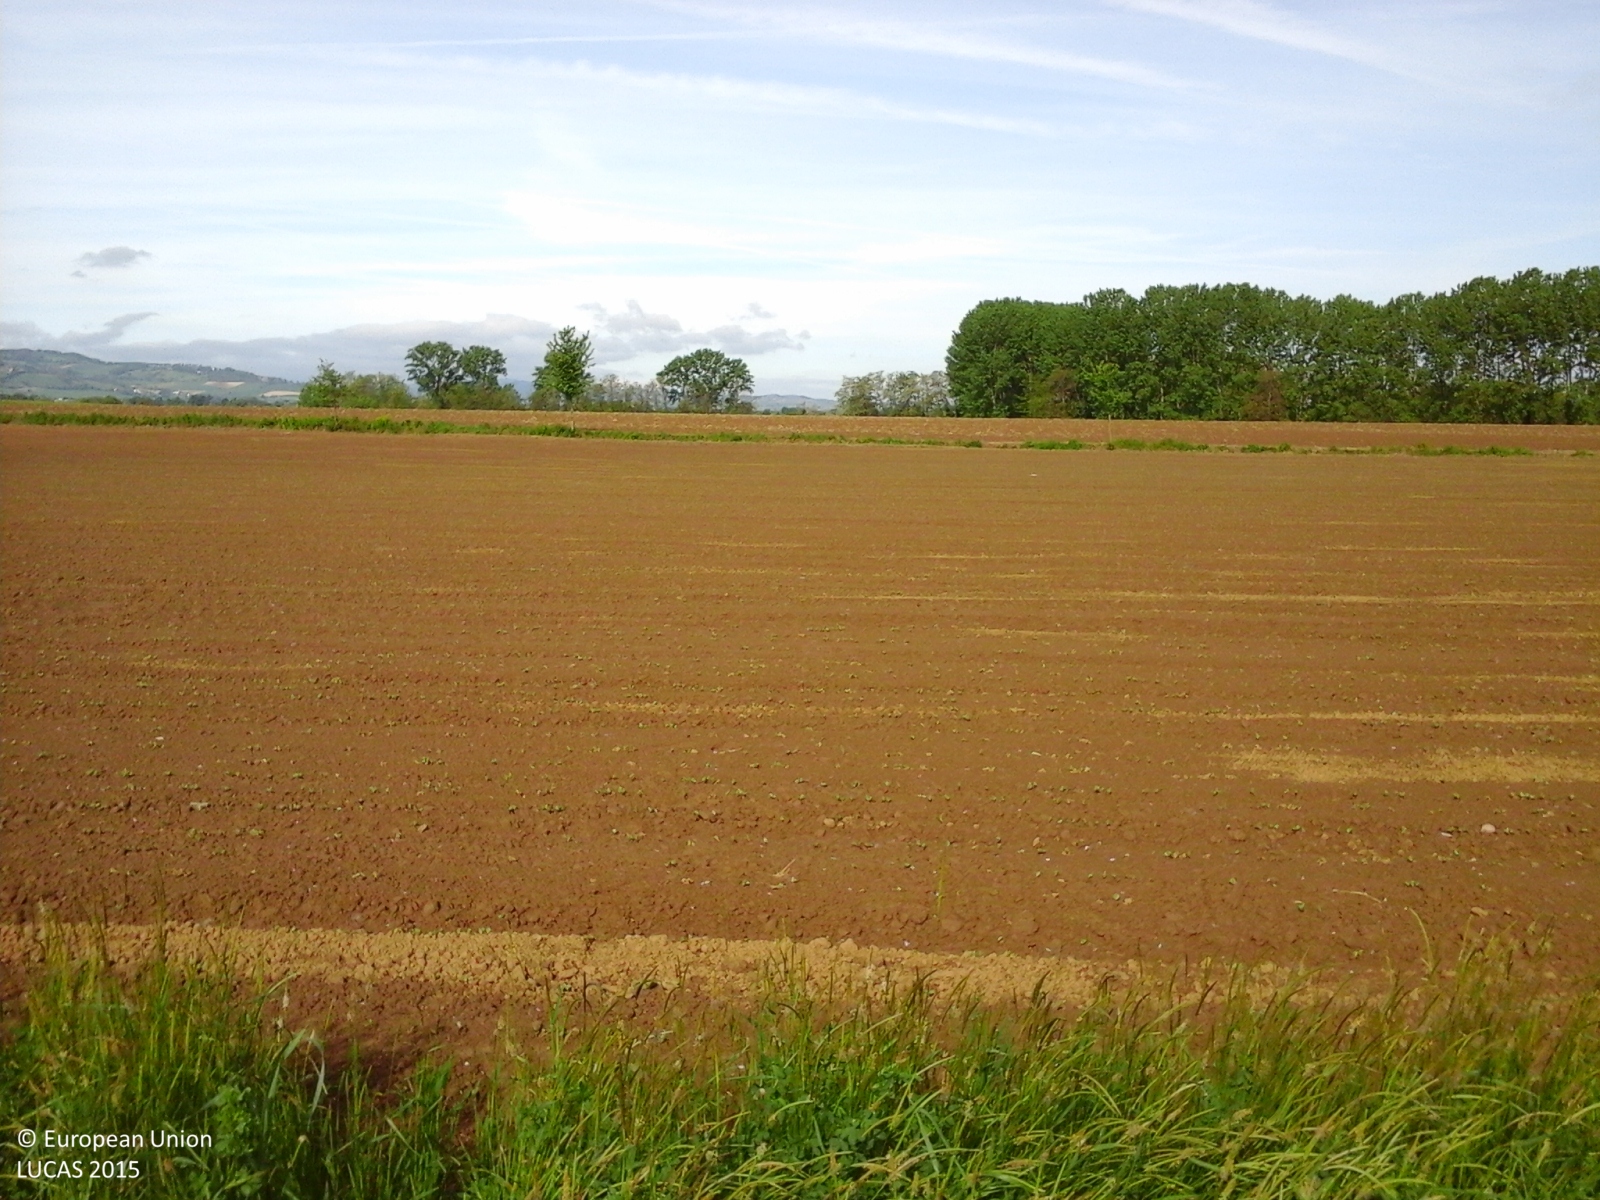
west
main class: Cropland
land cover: Lucerne
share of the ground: > 75 %
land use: Agriculture (excluding fallow land and kitchen gardens)
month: May
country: IT
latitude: 44.9807
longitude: 9.5570
